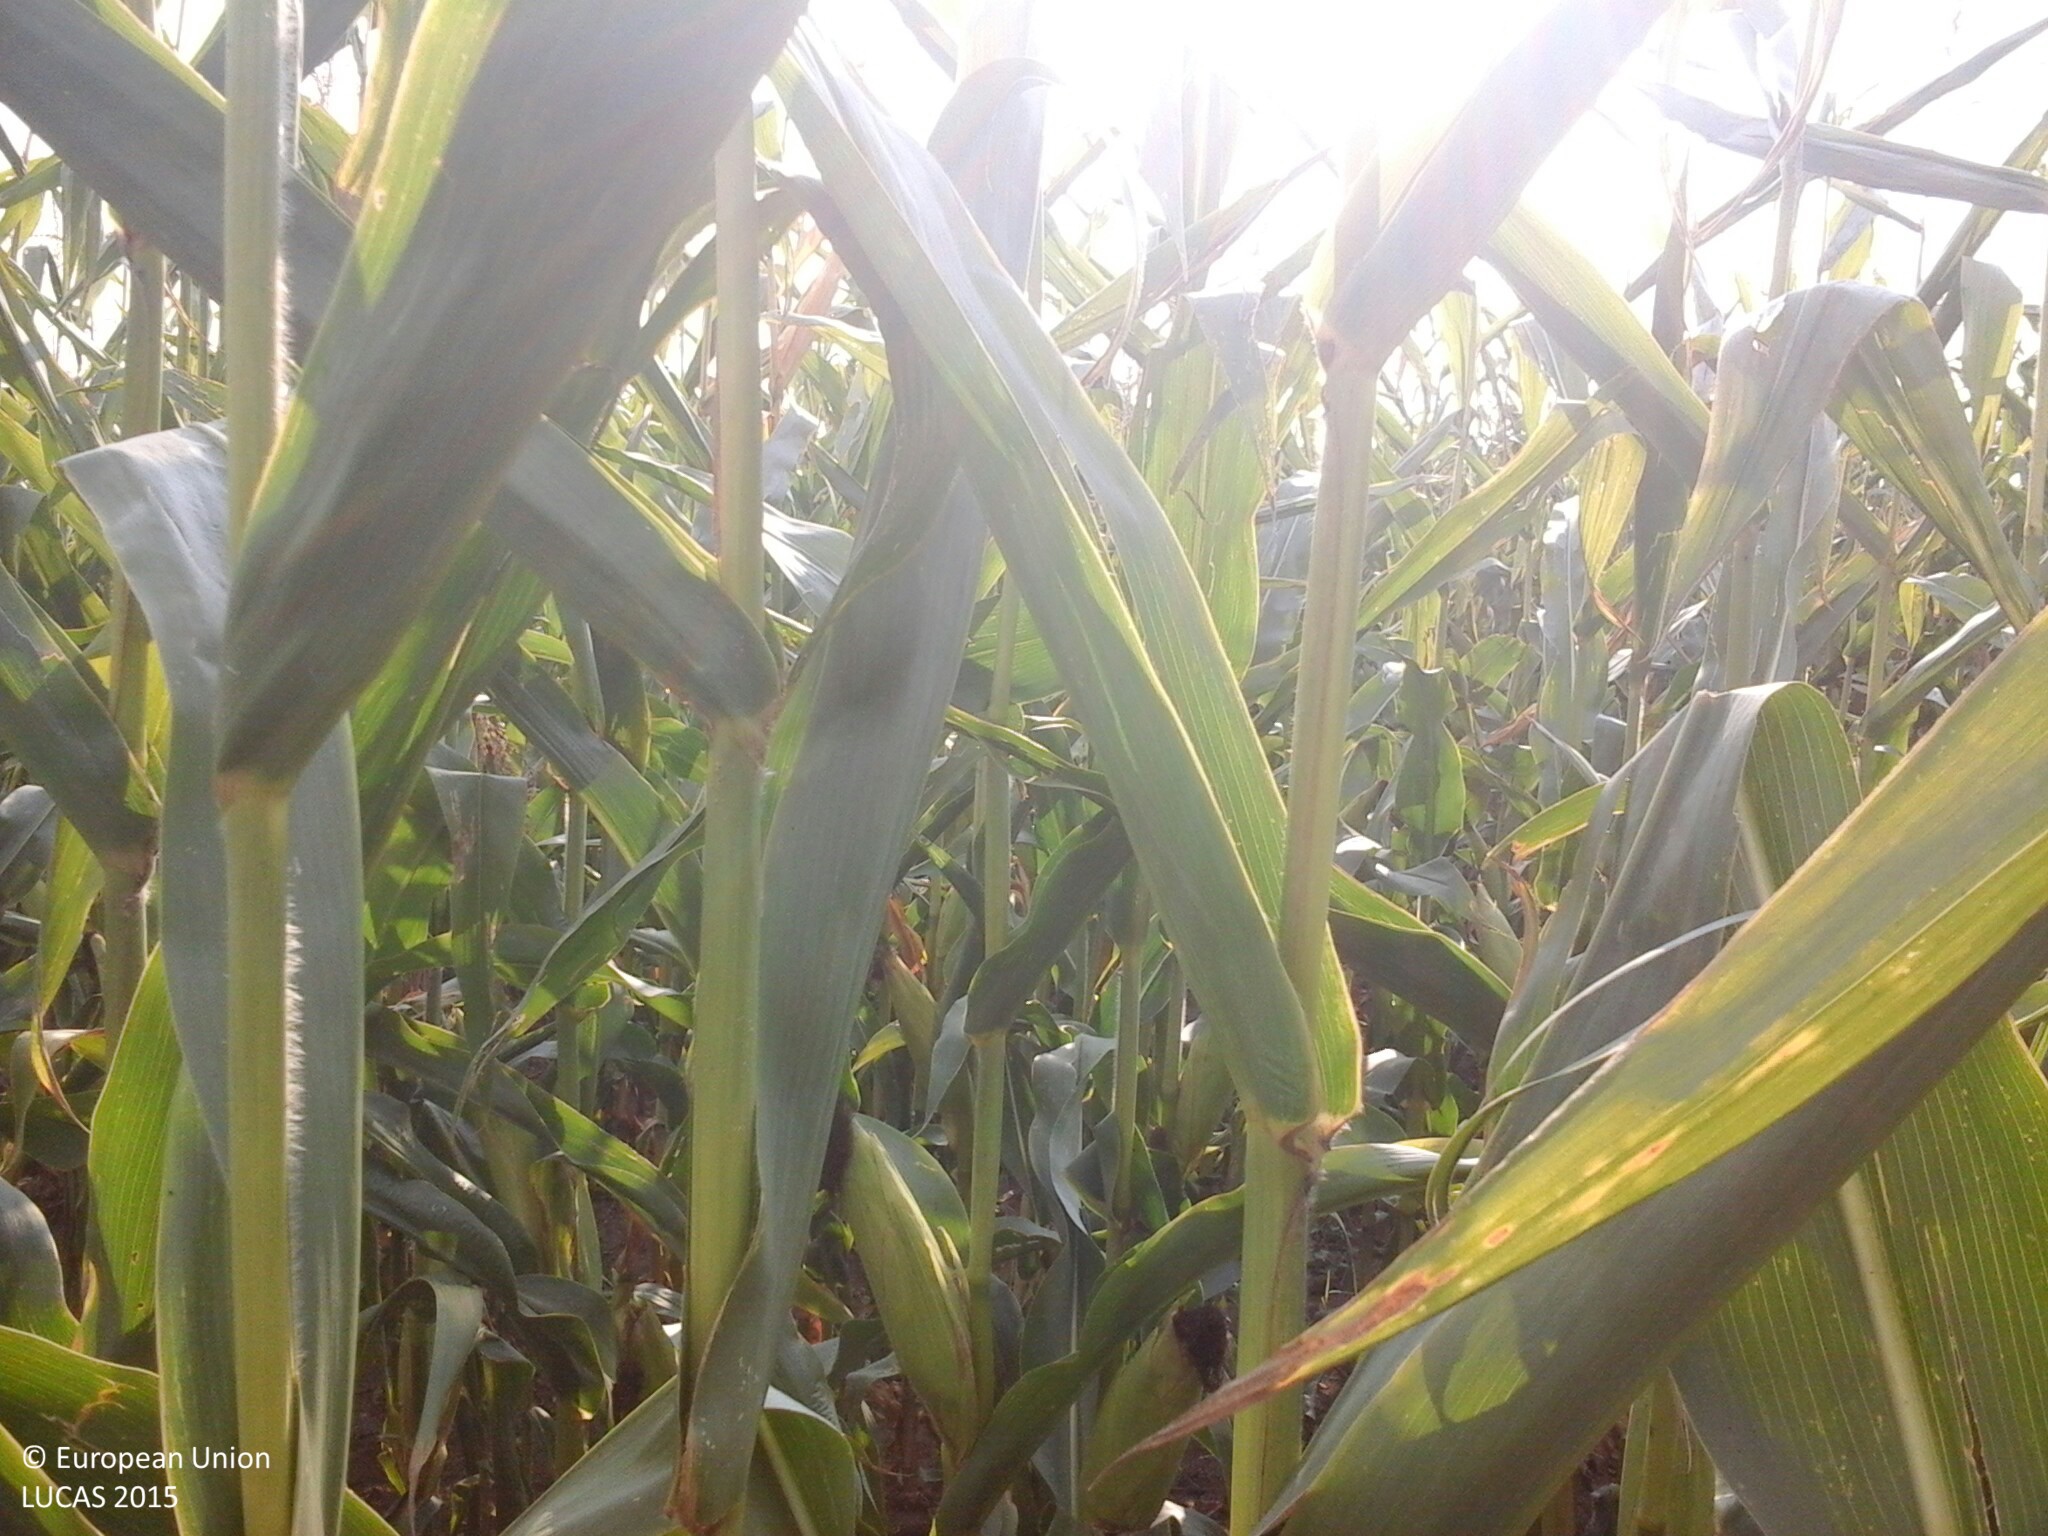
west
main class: Cropland
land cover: Maize
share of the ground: > 75 %
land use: Agriculture (excluding fallow land and kitchen gardens)
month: August
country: HU
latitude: 46.8517
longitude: 18.4178
